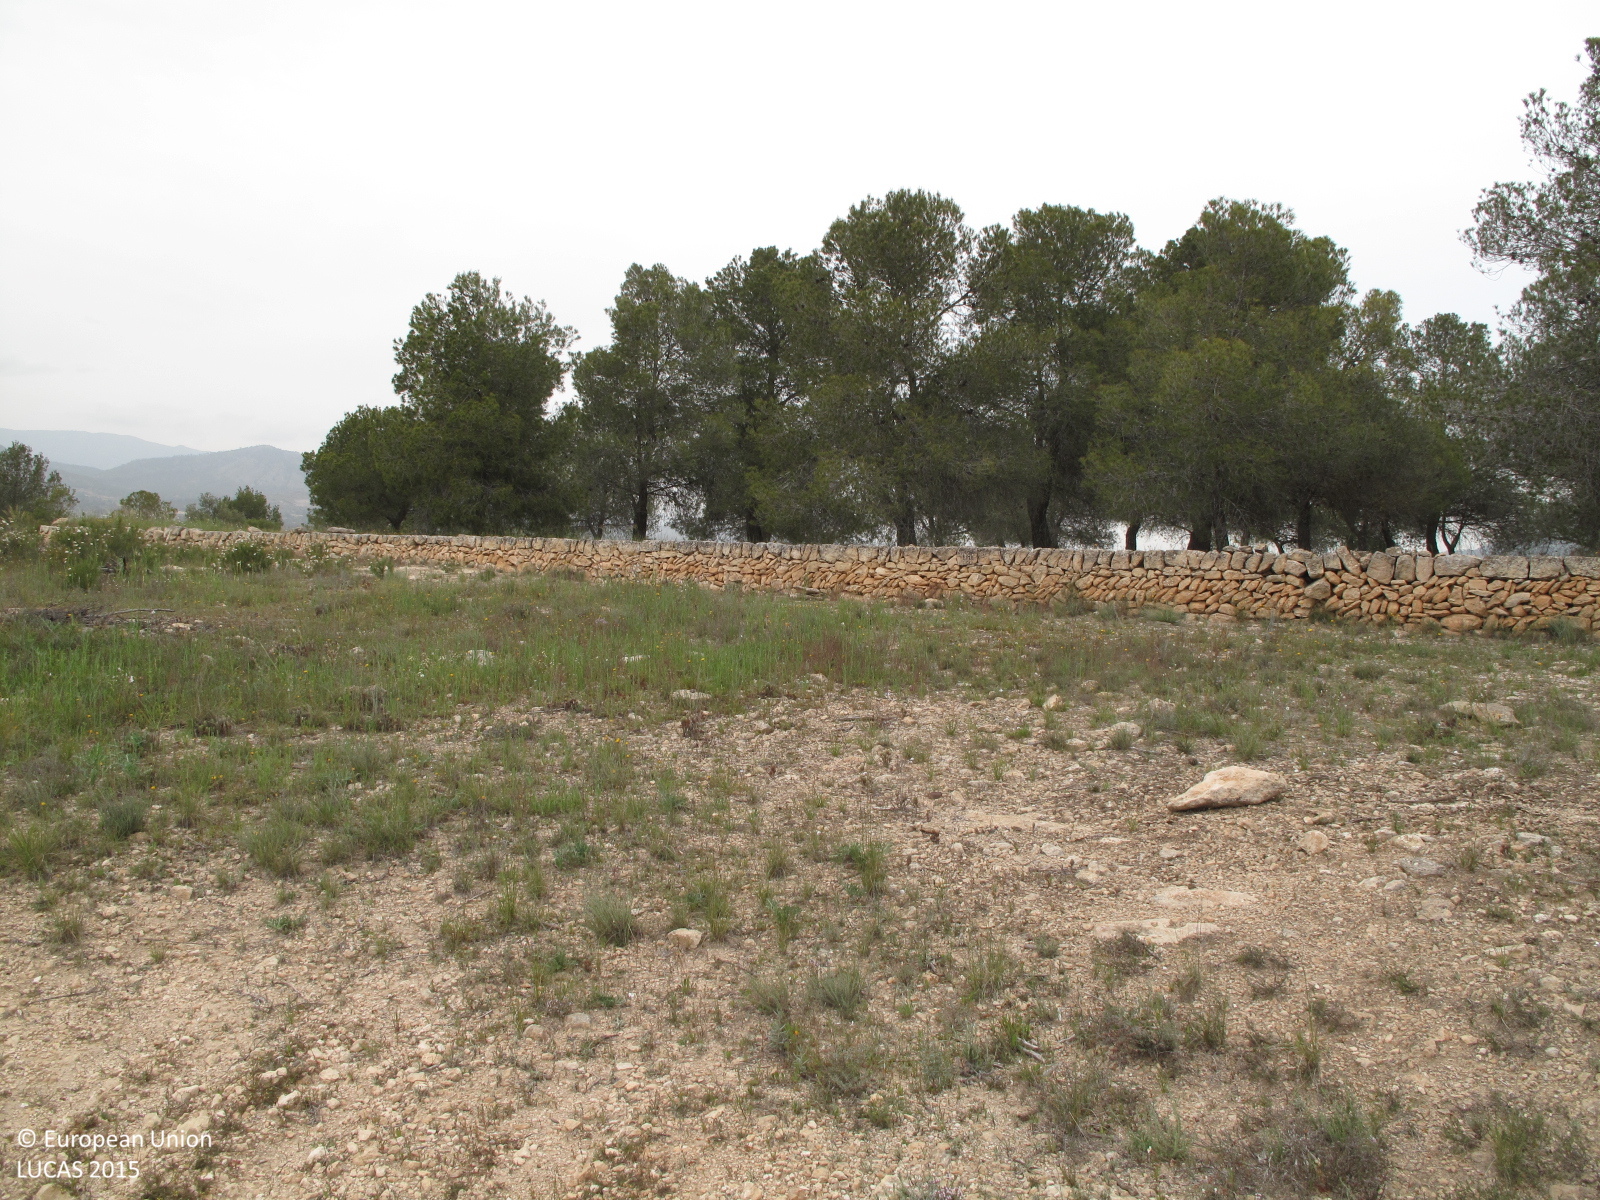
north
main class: Cropland
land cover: Nuts trees
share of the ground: < 10 %
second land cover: Spontaneously vegetated surfaces
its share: > 75 %
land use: Agriculture (excluding fallow land and kitchen gardens)
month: April
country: ES
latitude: 38.4344
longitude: -0.9057
